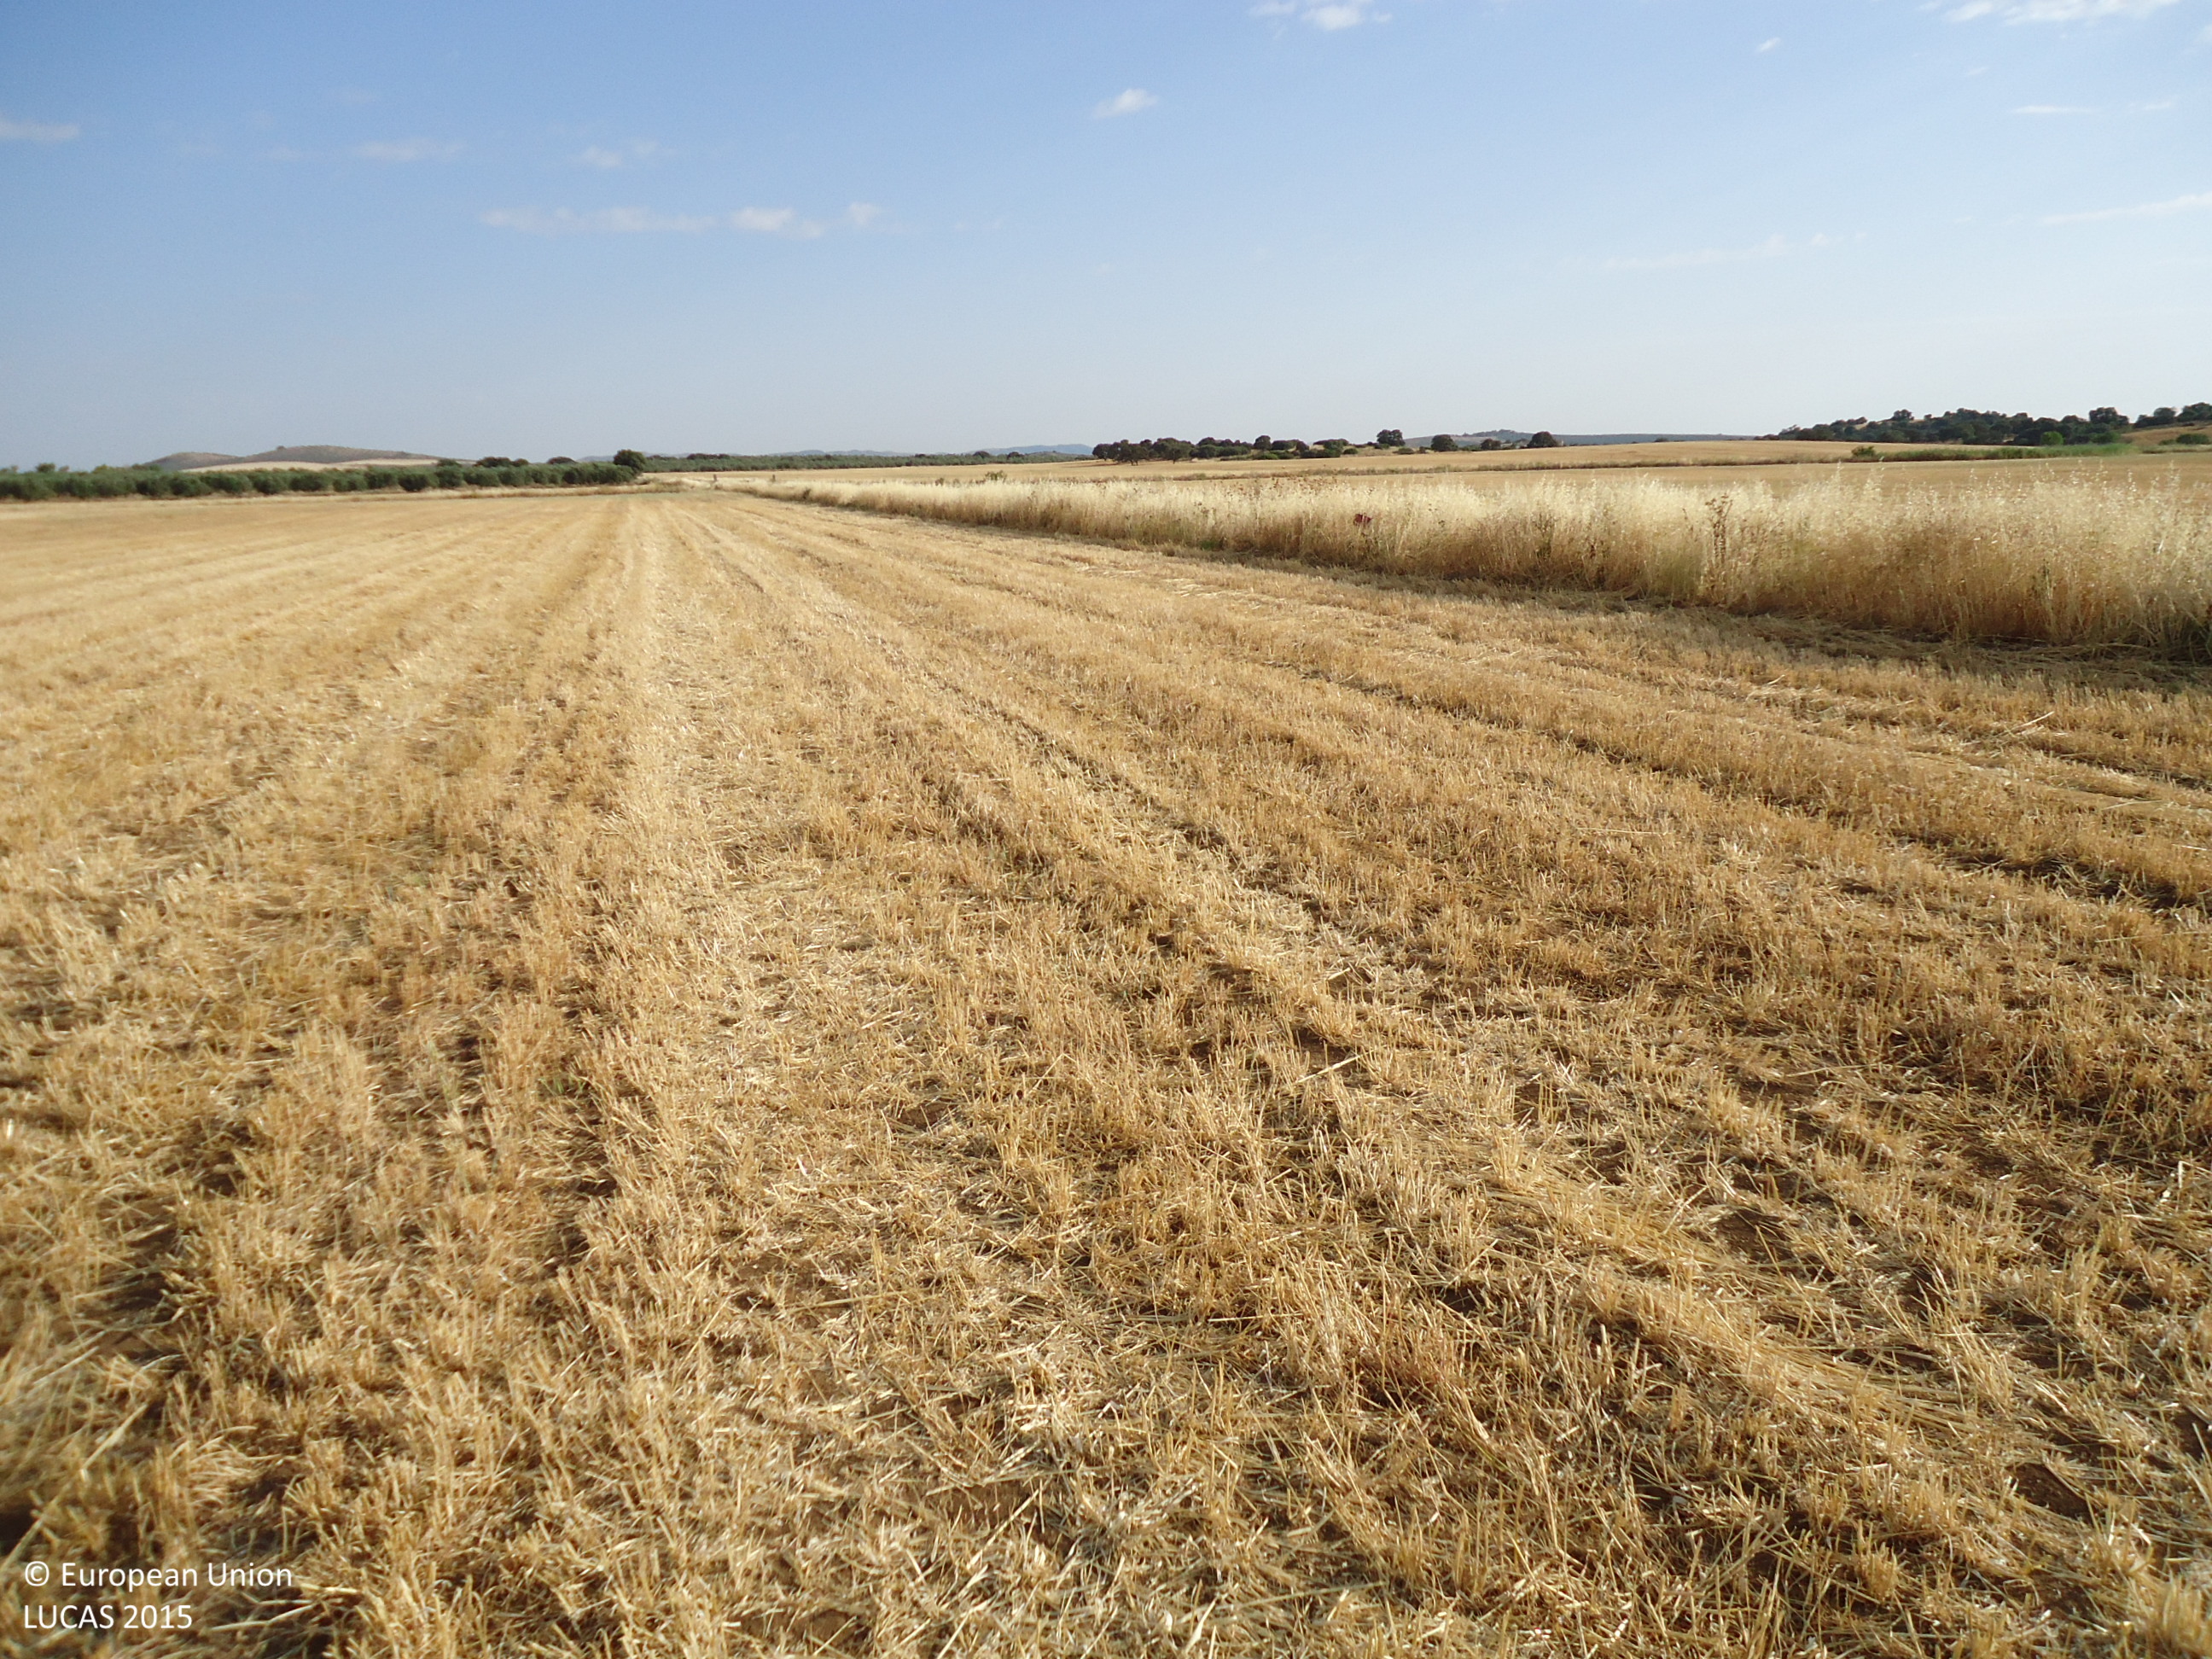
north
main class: Cropland
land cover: Oats
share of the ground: < 10 %
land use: Agriculture (excluding fallow land and kitchen gardens)
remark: Harvested field
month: June
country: ES
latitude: 37.0058
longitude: -4.7997
